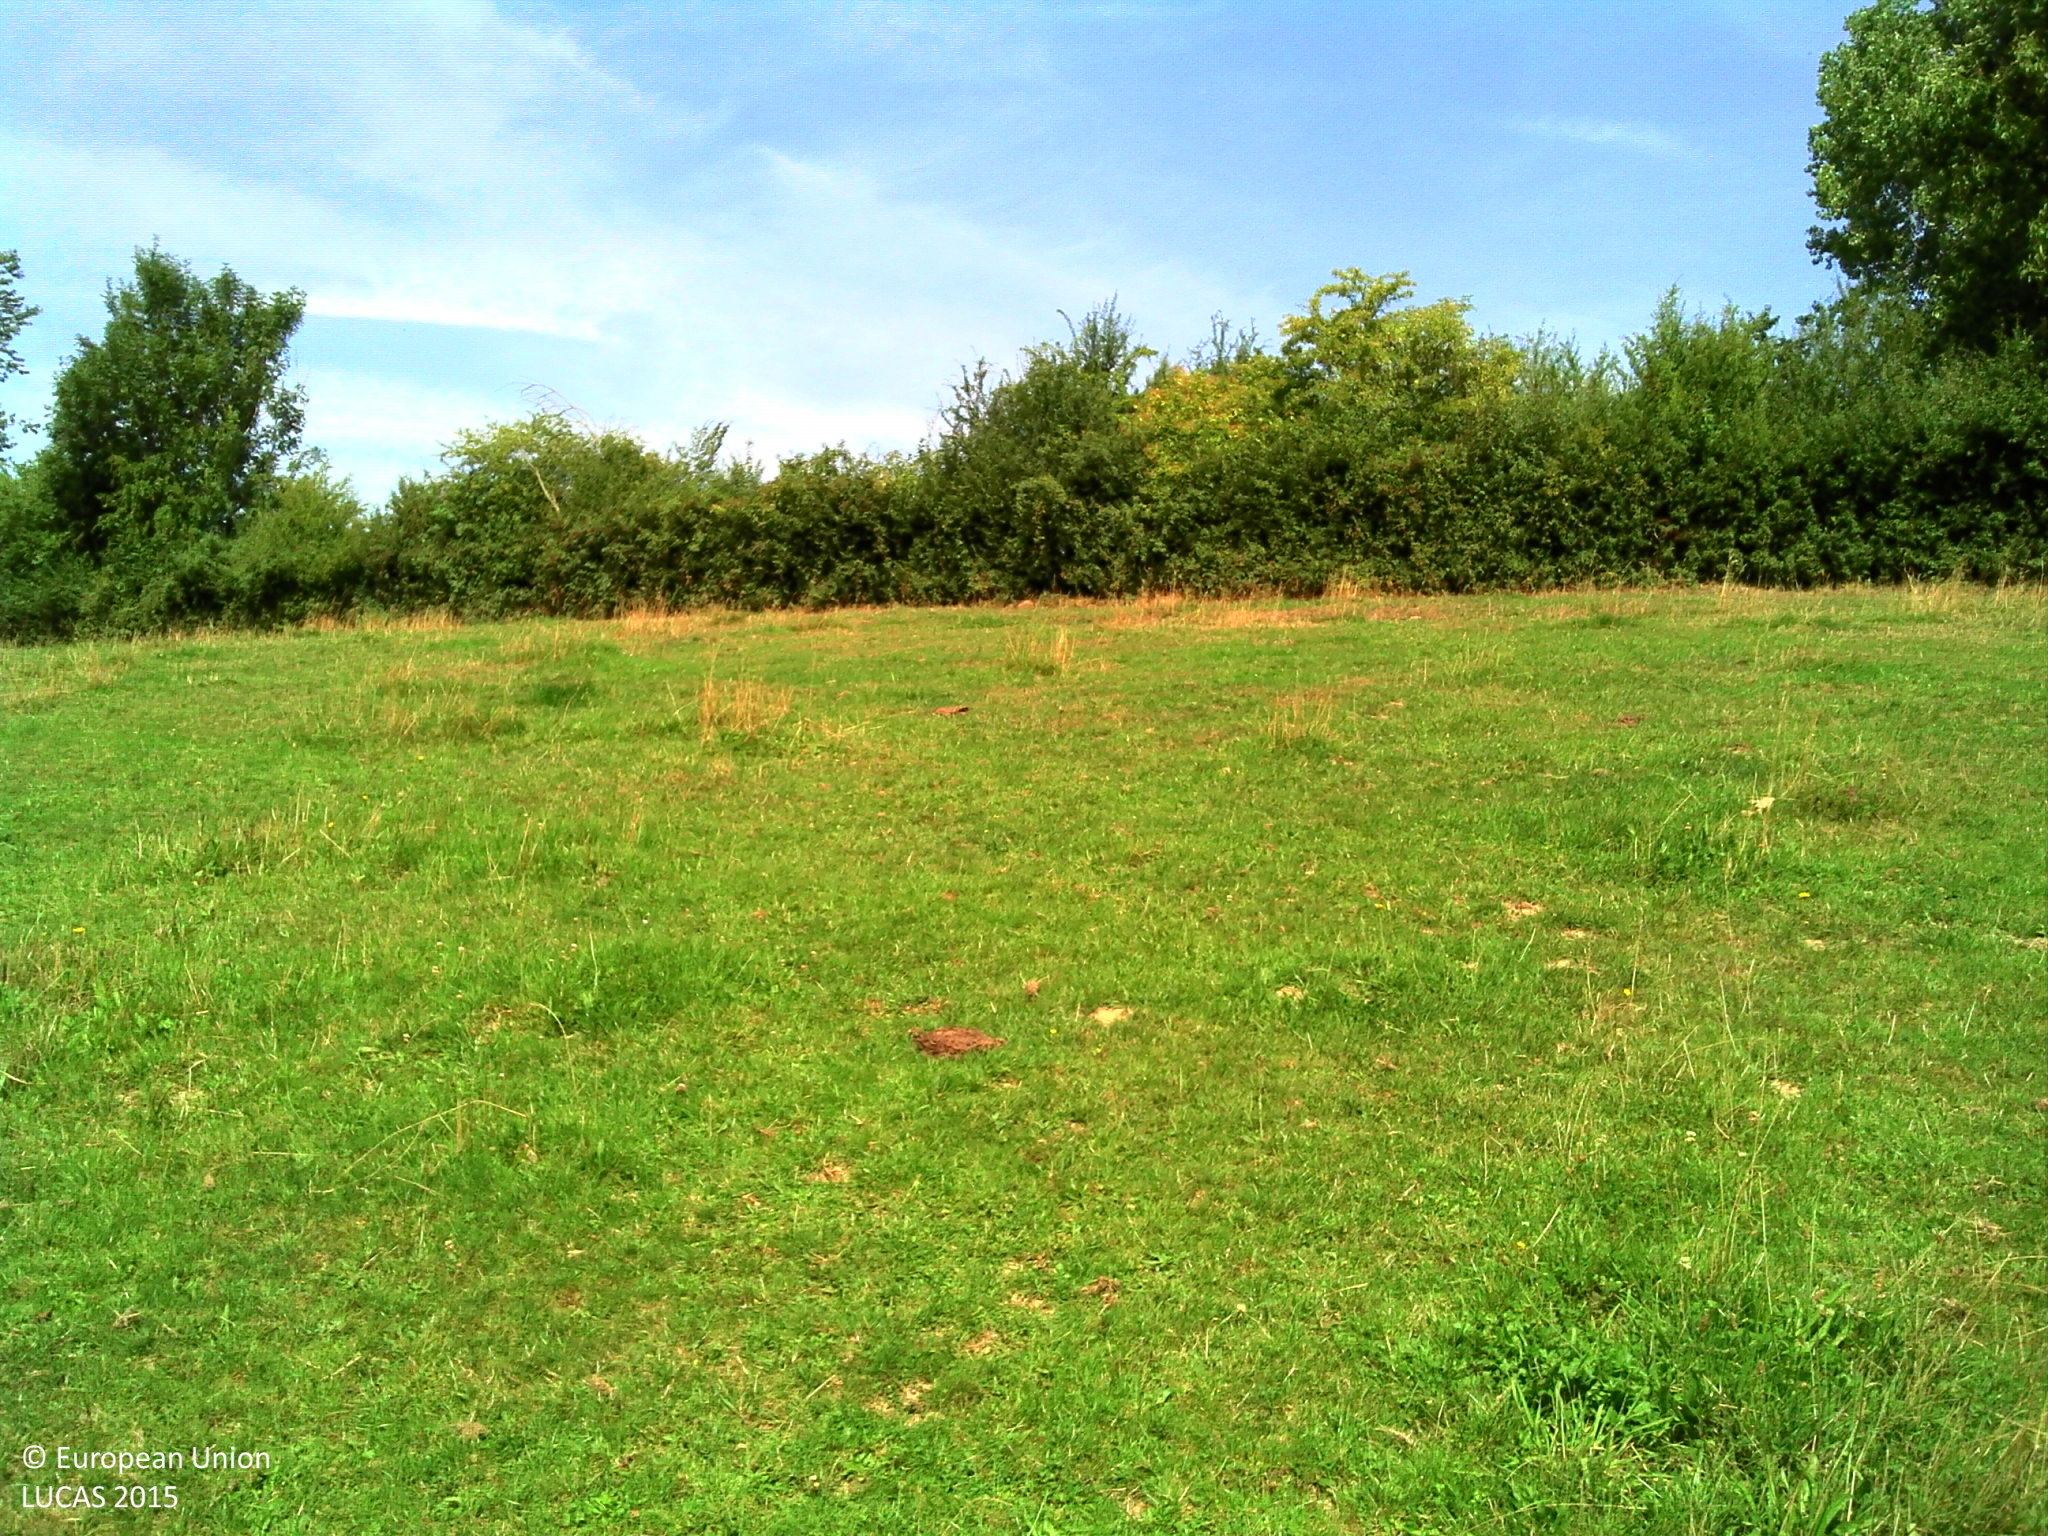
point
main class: Grassland
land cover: Grassland without tree/shrub cover
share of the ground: > 75 %
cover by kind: herbaceous plants 100 %
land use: Agriculture (excluding fallow land and kitchen gardens)
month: August
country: FR
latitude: 50.2430
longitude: 4.0069
